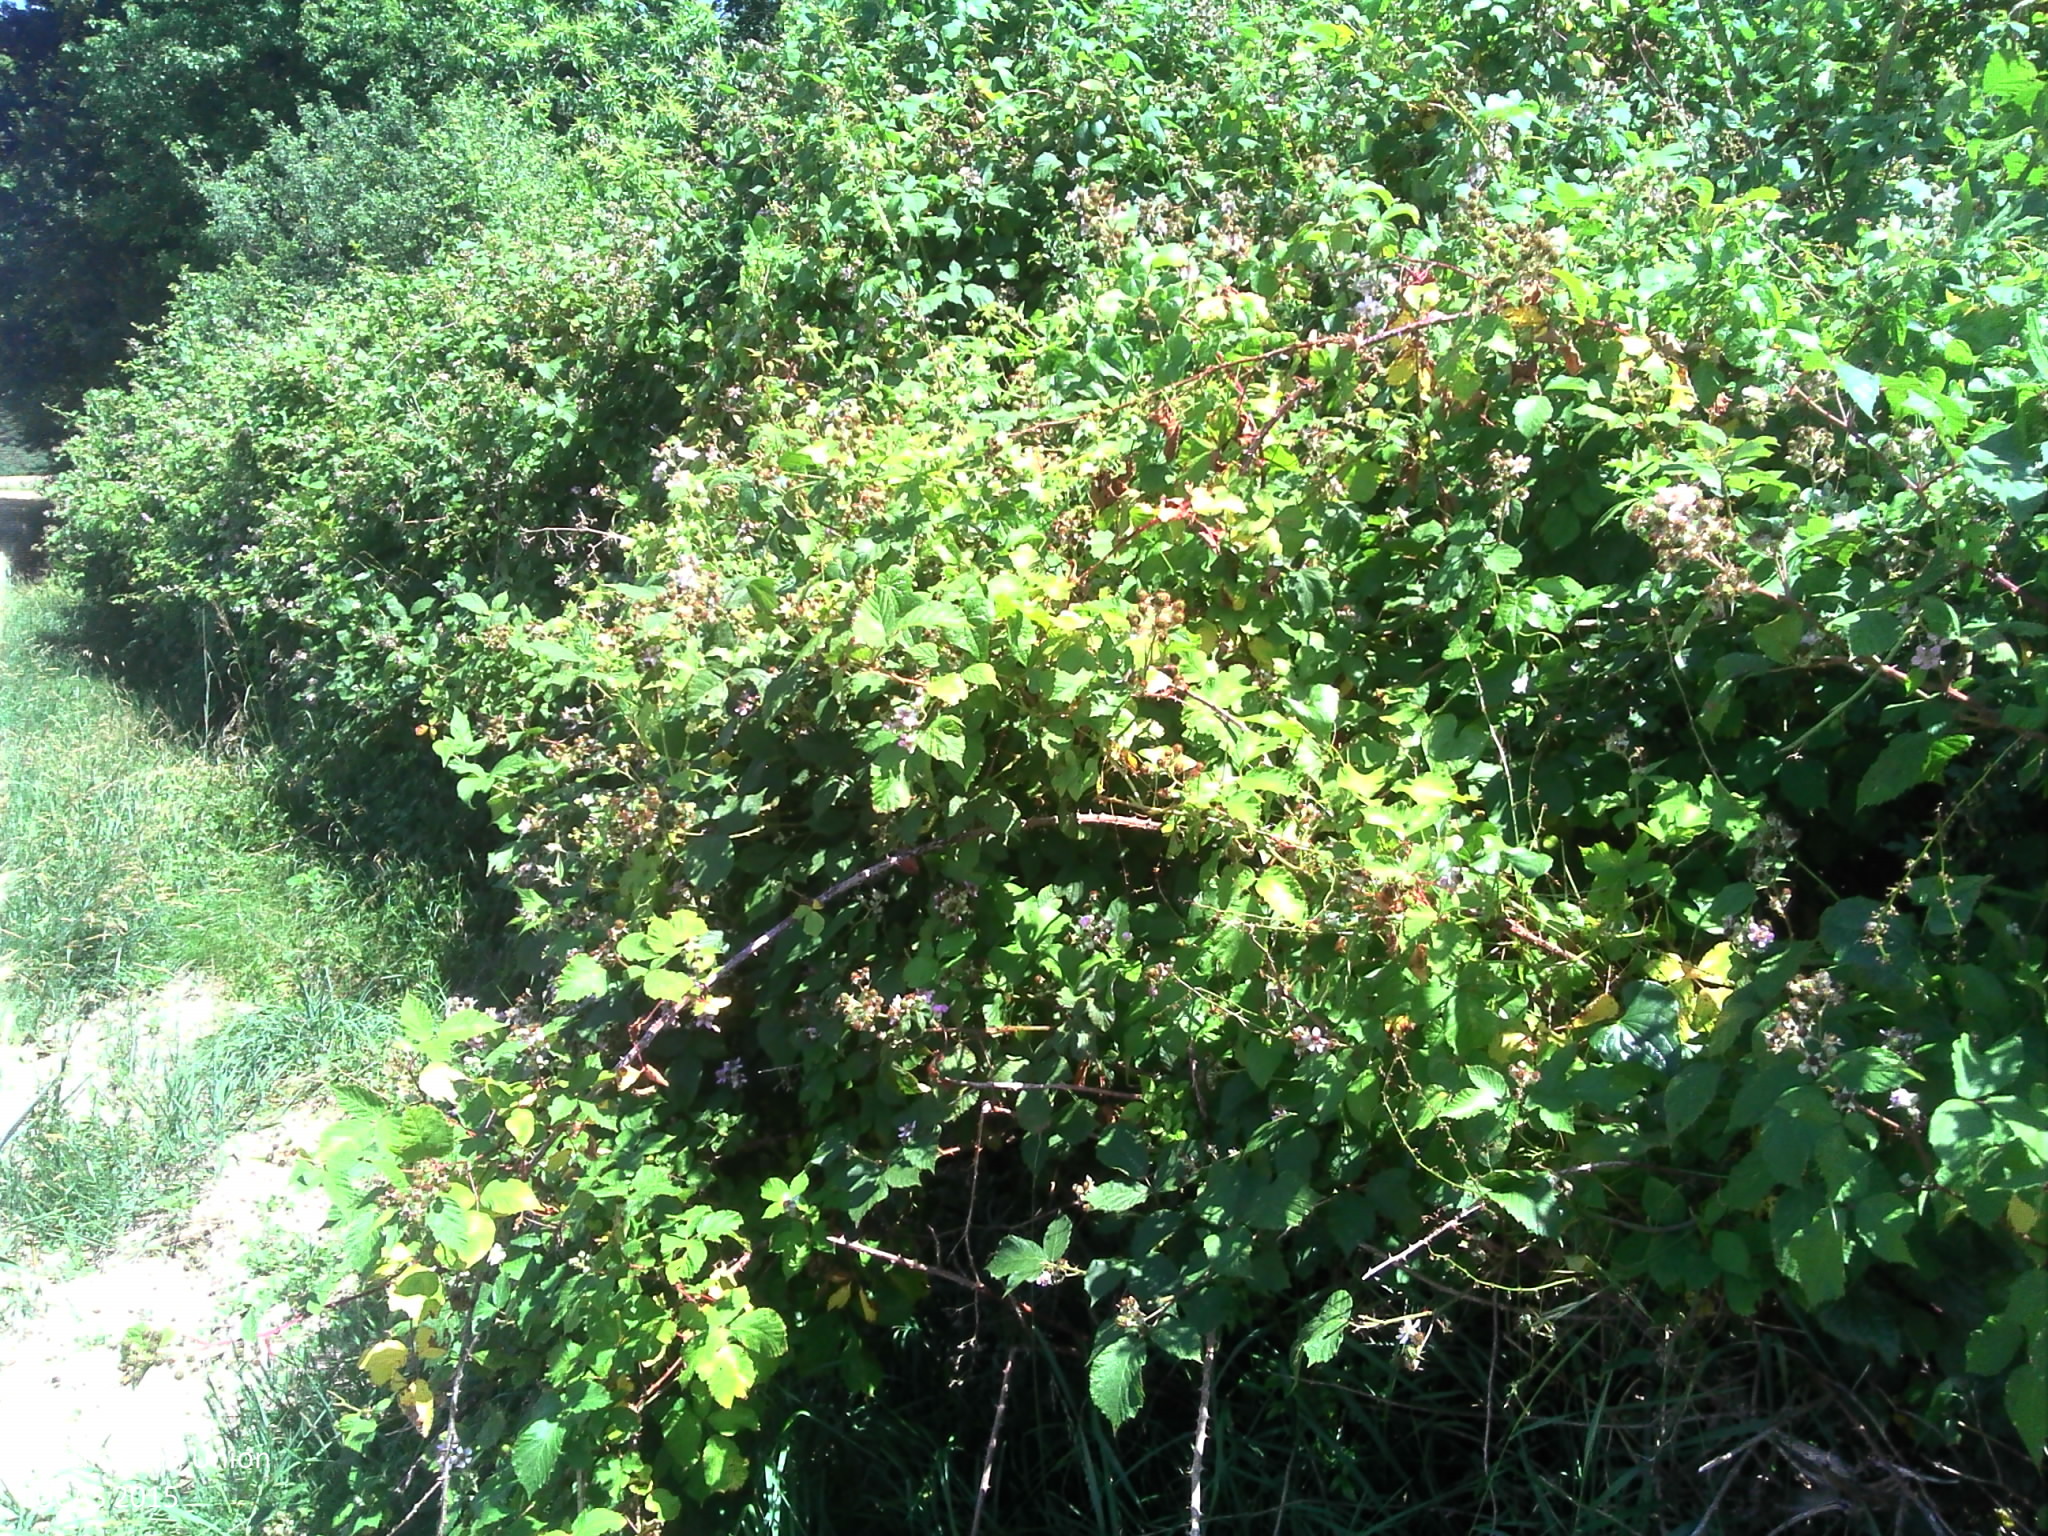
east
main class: Cropland
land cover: Durum wheat
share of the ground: > 75 %
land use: Agriculture (excluding fallow land and kitchen gardens)
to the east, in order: Durum wheat; Grass margins; Paved roads, cycling and walking lanes; Grass margins; Ditches and canals; Electric lines; Fences; Grassland without tree/shrub cover; Fences; Grass margins; Durum wheat
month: June
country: FR
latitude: 47.2911
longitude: 1.1915
